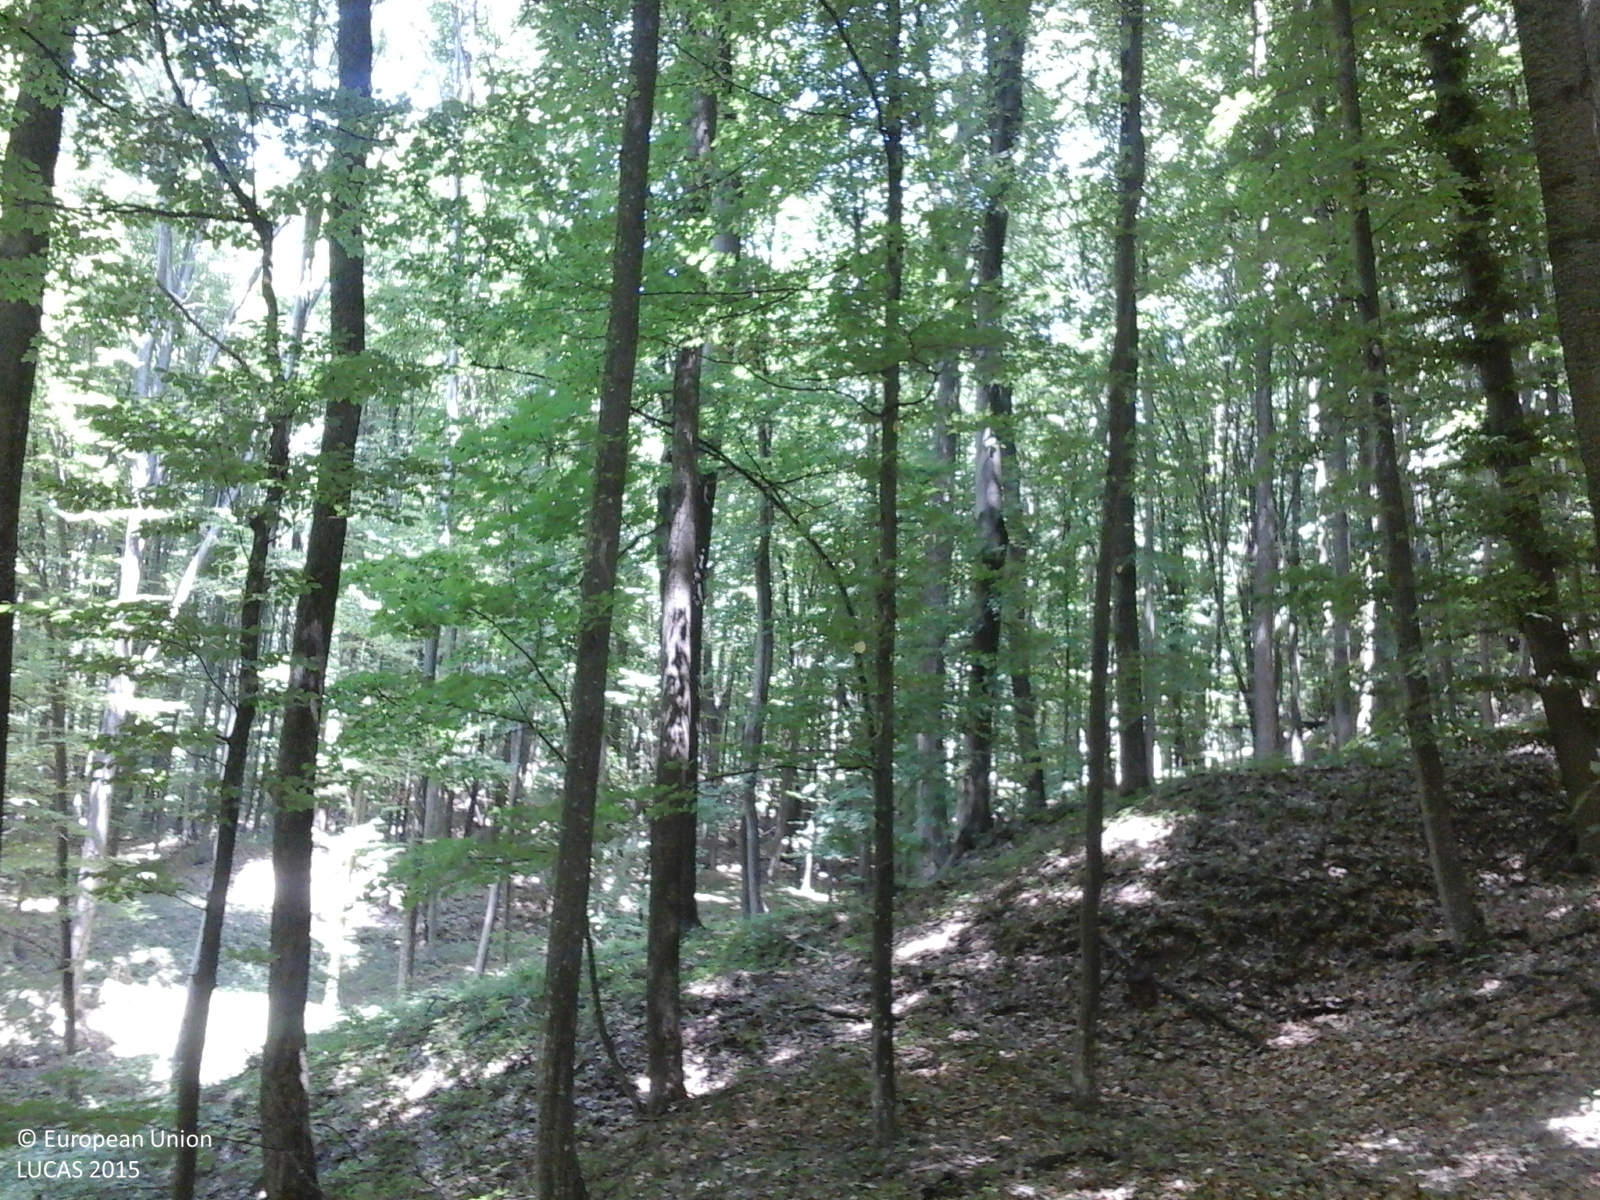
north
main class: Woodland
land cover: Broadleaved woodland
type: beech forest
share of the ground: > 75 %
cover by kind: broadleaved forest trees 100 %
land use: Forestry
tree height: > 5 m
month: June
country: RO
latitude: 46.7806
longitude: 27.2233
